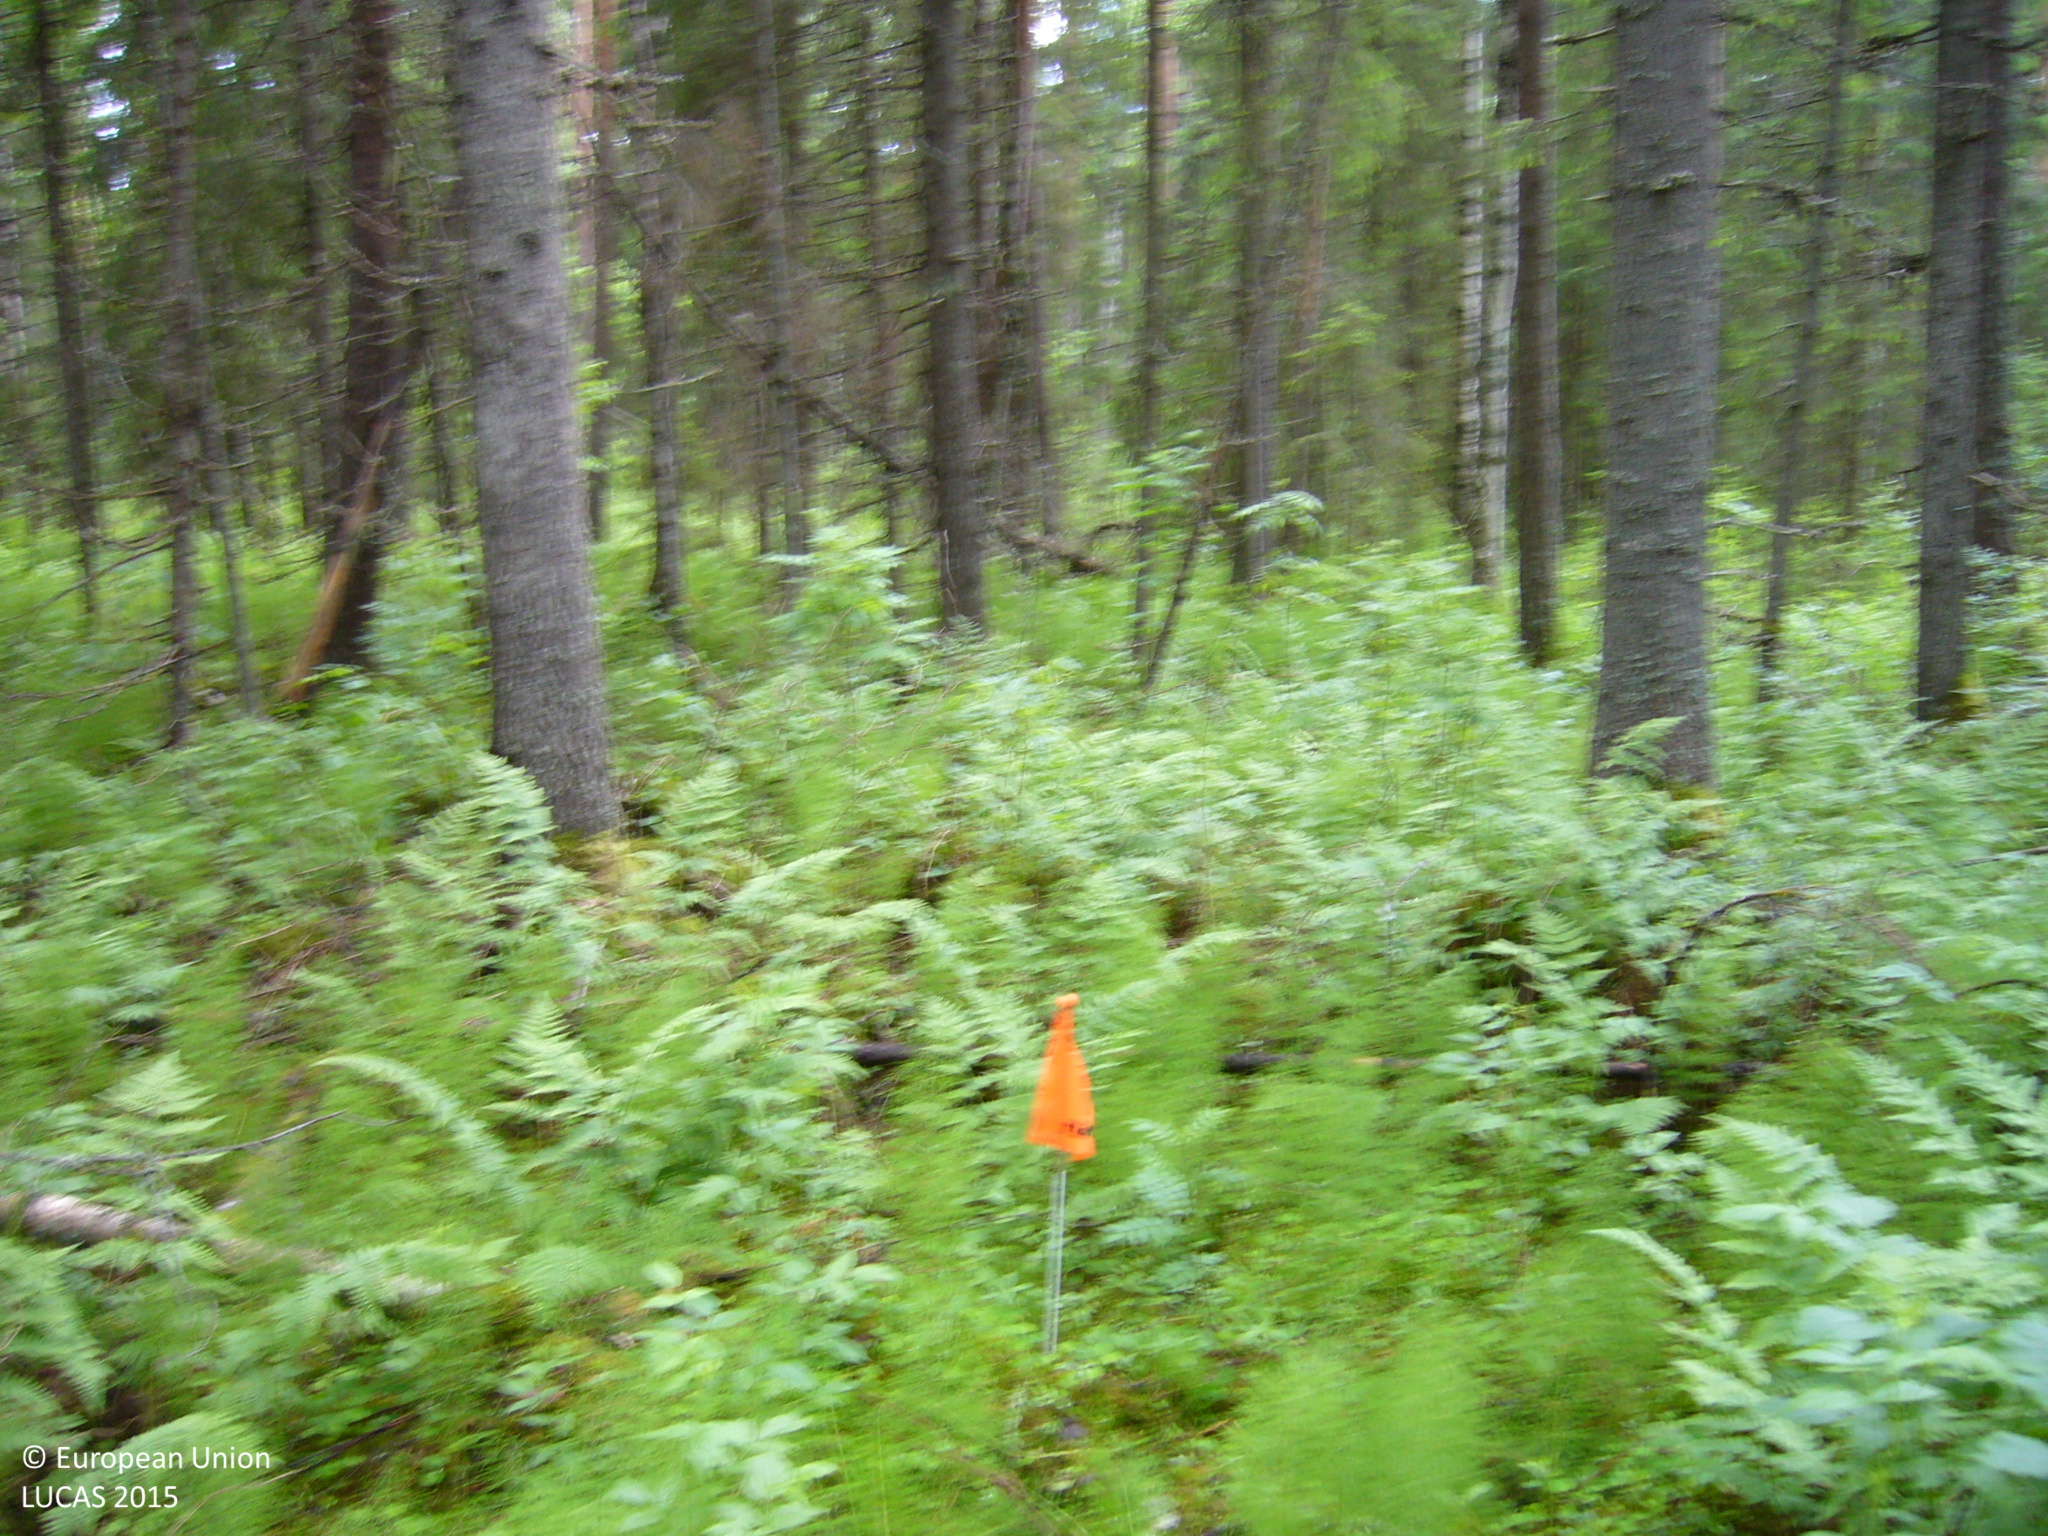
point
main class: Woodland
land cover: Spruce dominated coniferous woodland
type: boreal forest
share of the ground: > 75 %
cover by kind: coniferous forest trees 80 %, broadleaved forest trees 10 %, shrubs 10 %
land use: Forestry
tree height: > 5 m
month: June
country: FI
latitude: 63.7060
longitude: 26.3683
